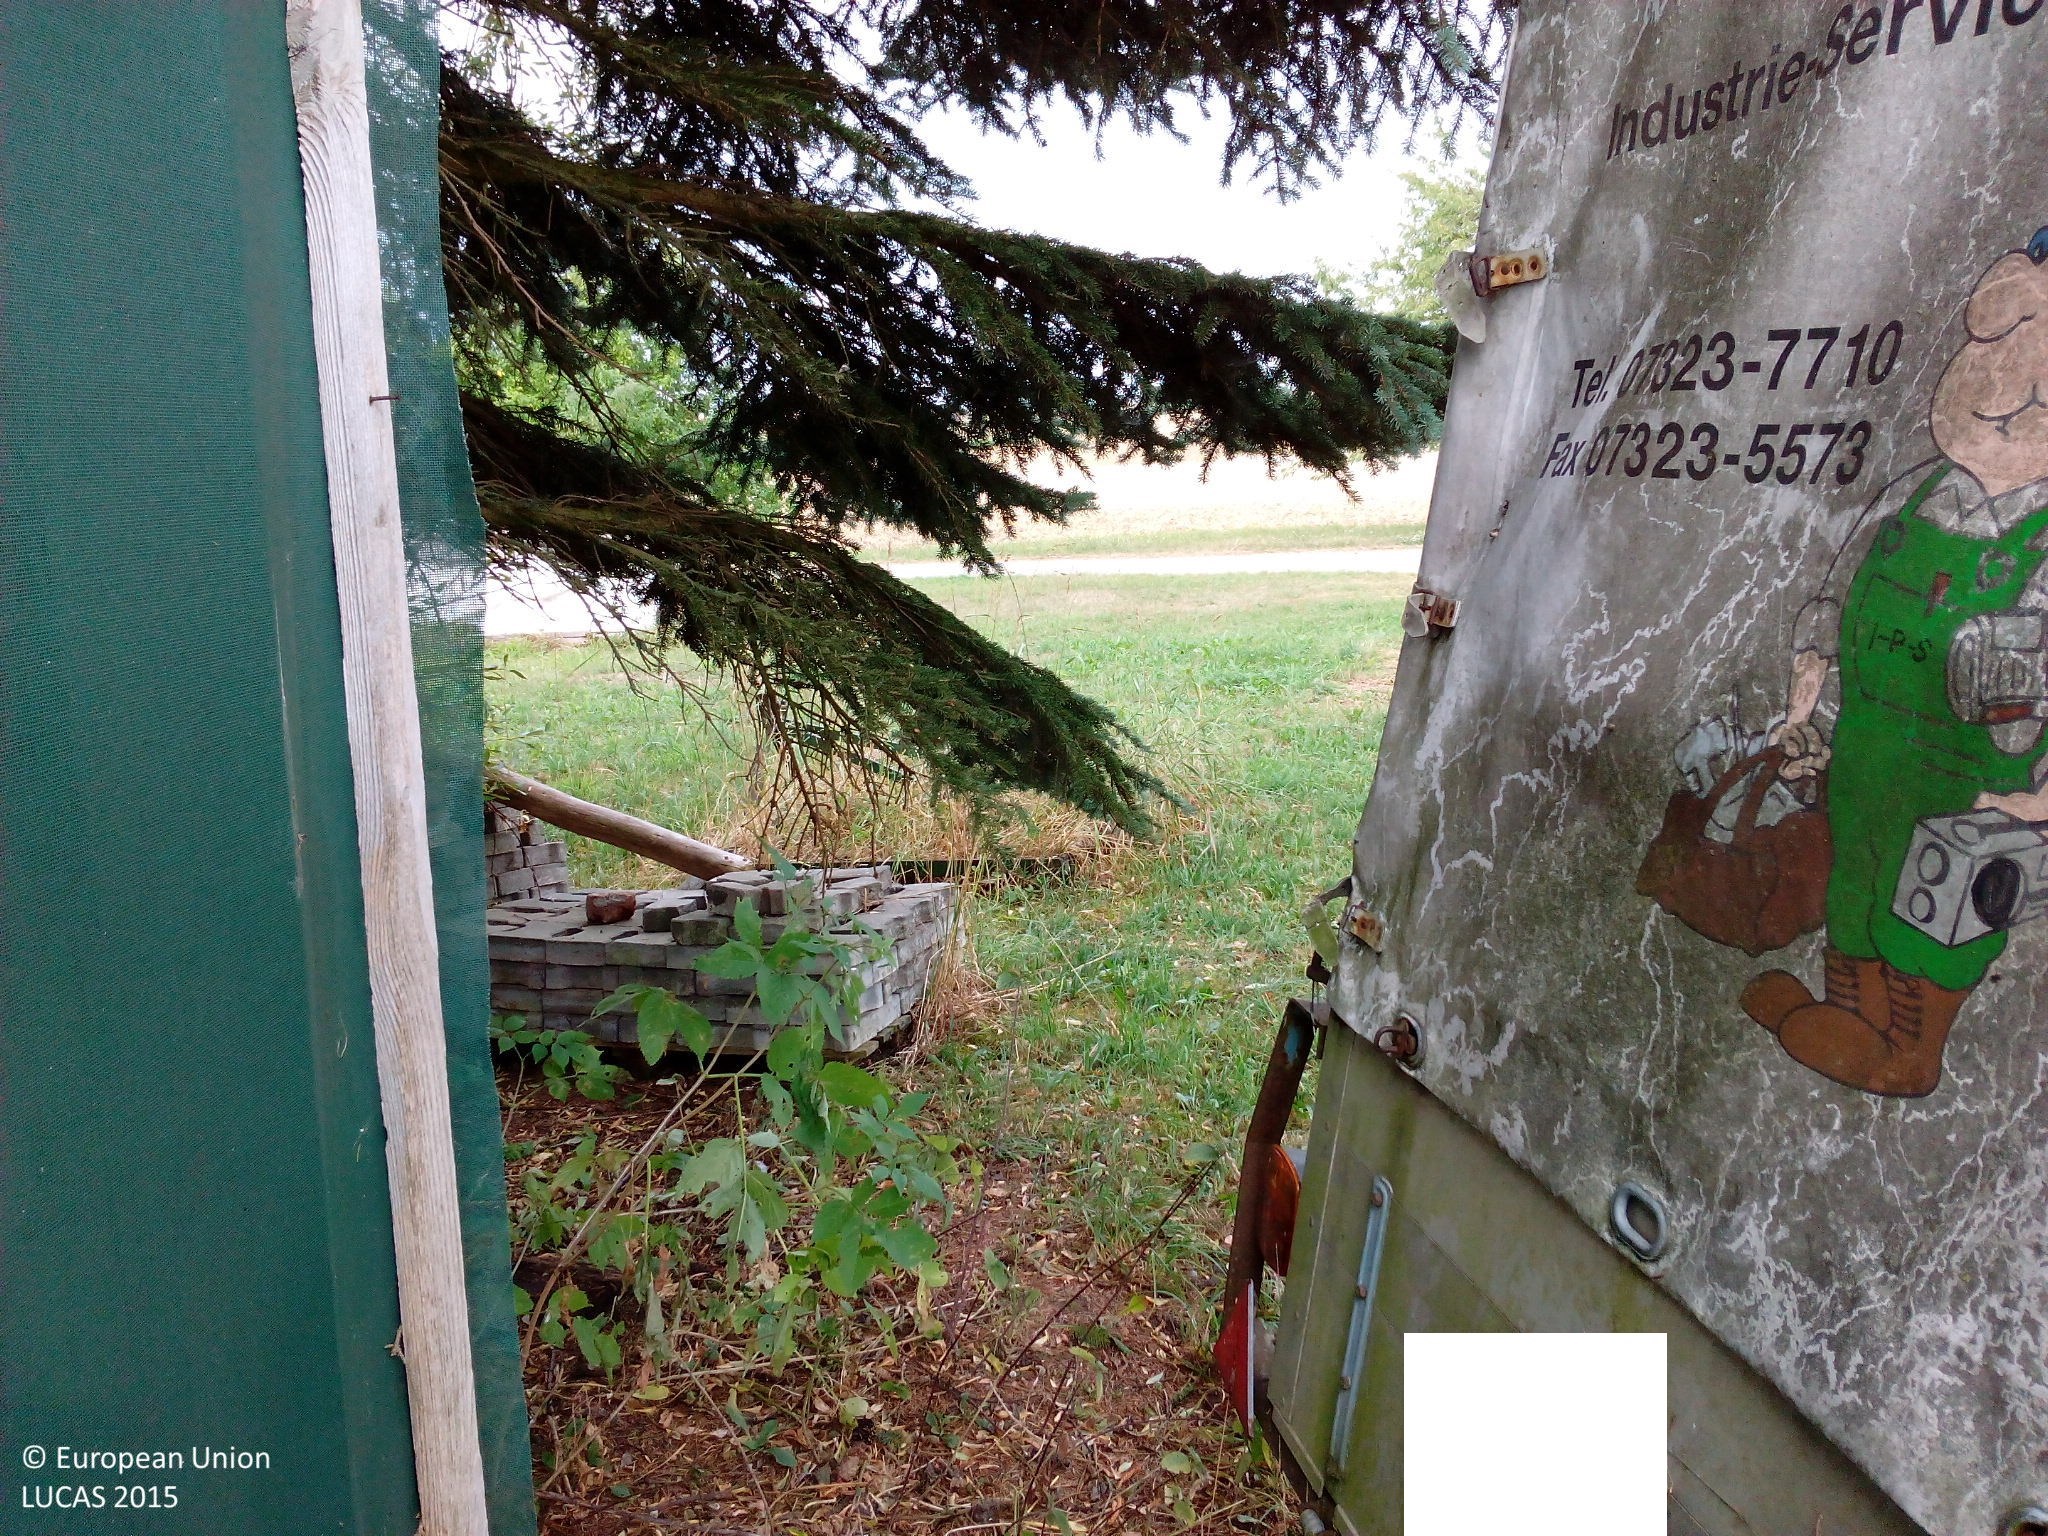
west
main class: Grassland
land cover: Grassland without tree/shrub cover
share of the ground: > 75 %
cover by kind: herbaceous plants 100 %
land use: Agriculture (excluding fallow land and kitchen gardens)
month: August
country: DE
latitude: 48.6554
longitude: 9.9593
